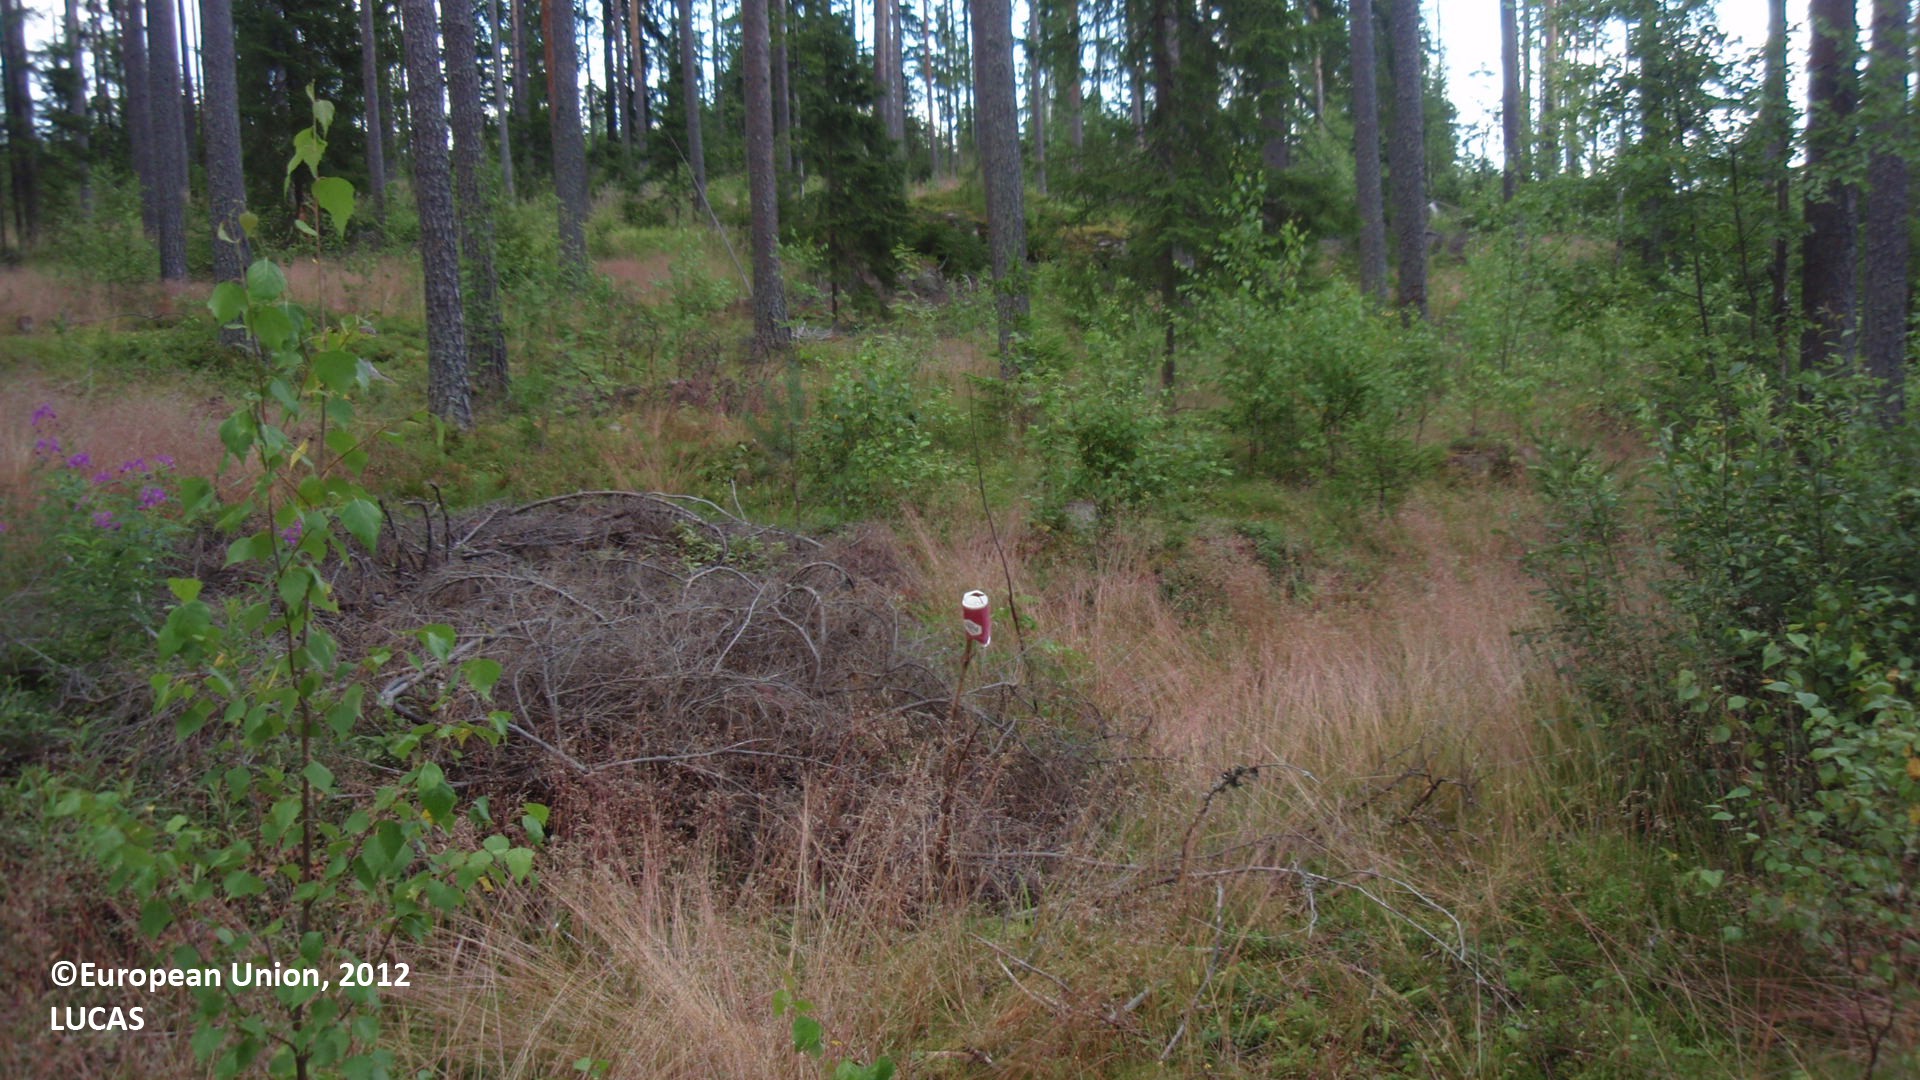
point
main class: Woodland
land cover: Pine dominated mixed woodland
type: boreal forest
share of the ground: 25 - 50 %
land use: Forestry
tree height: > 5 m
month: July
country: FI
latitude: 61.4217
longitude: 28.9895
